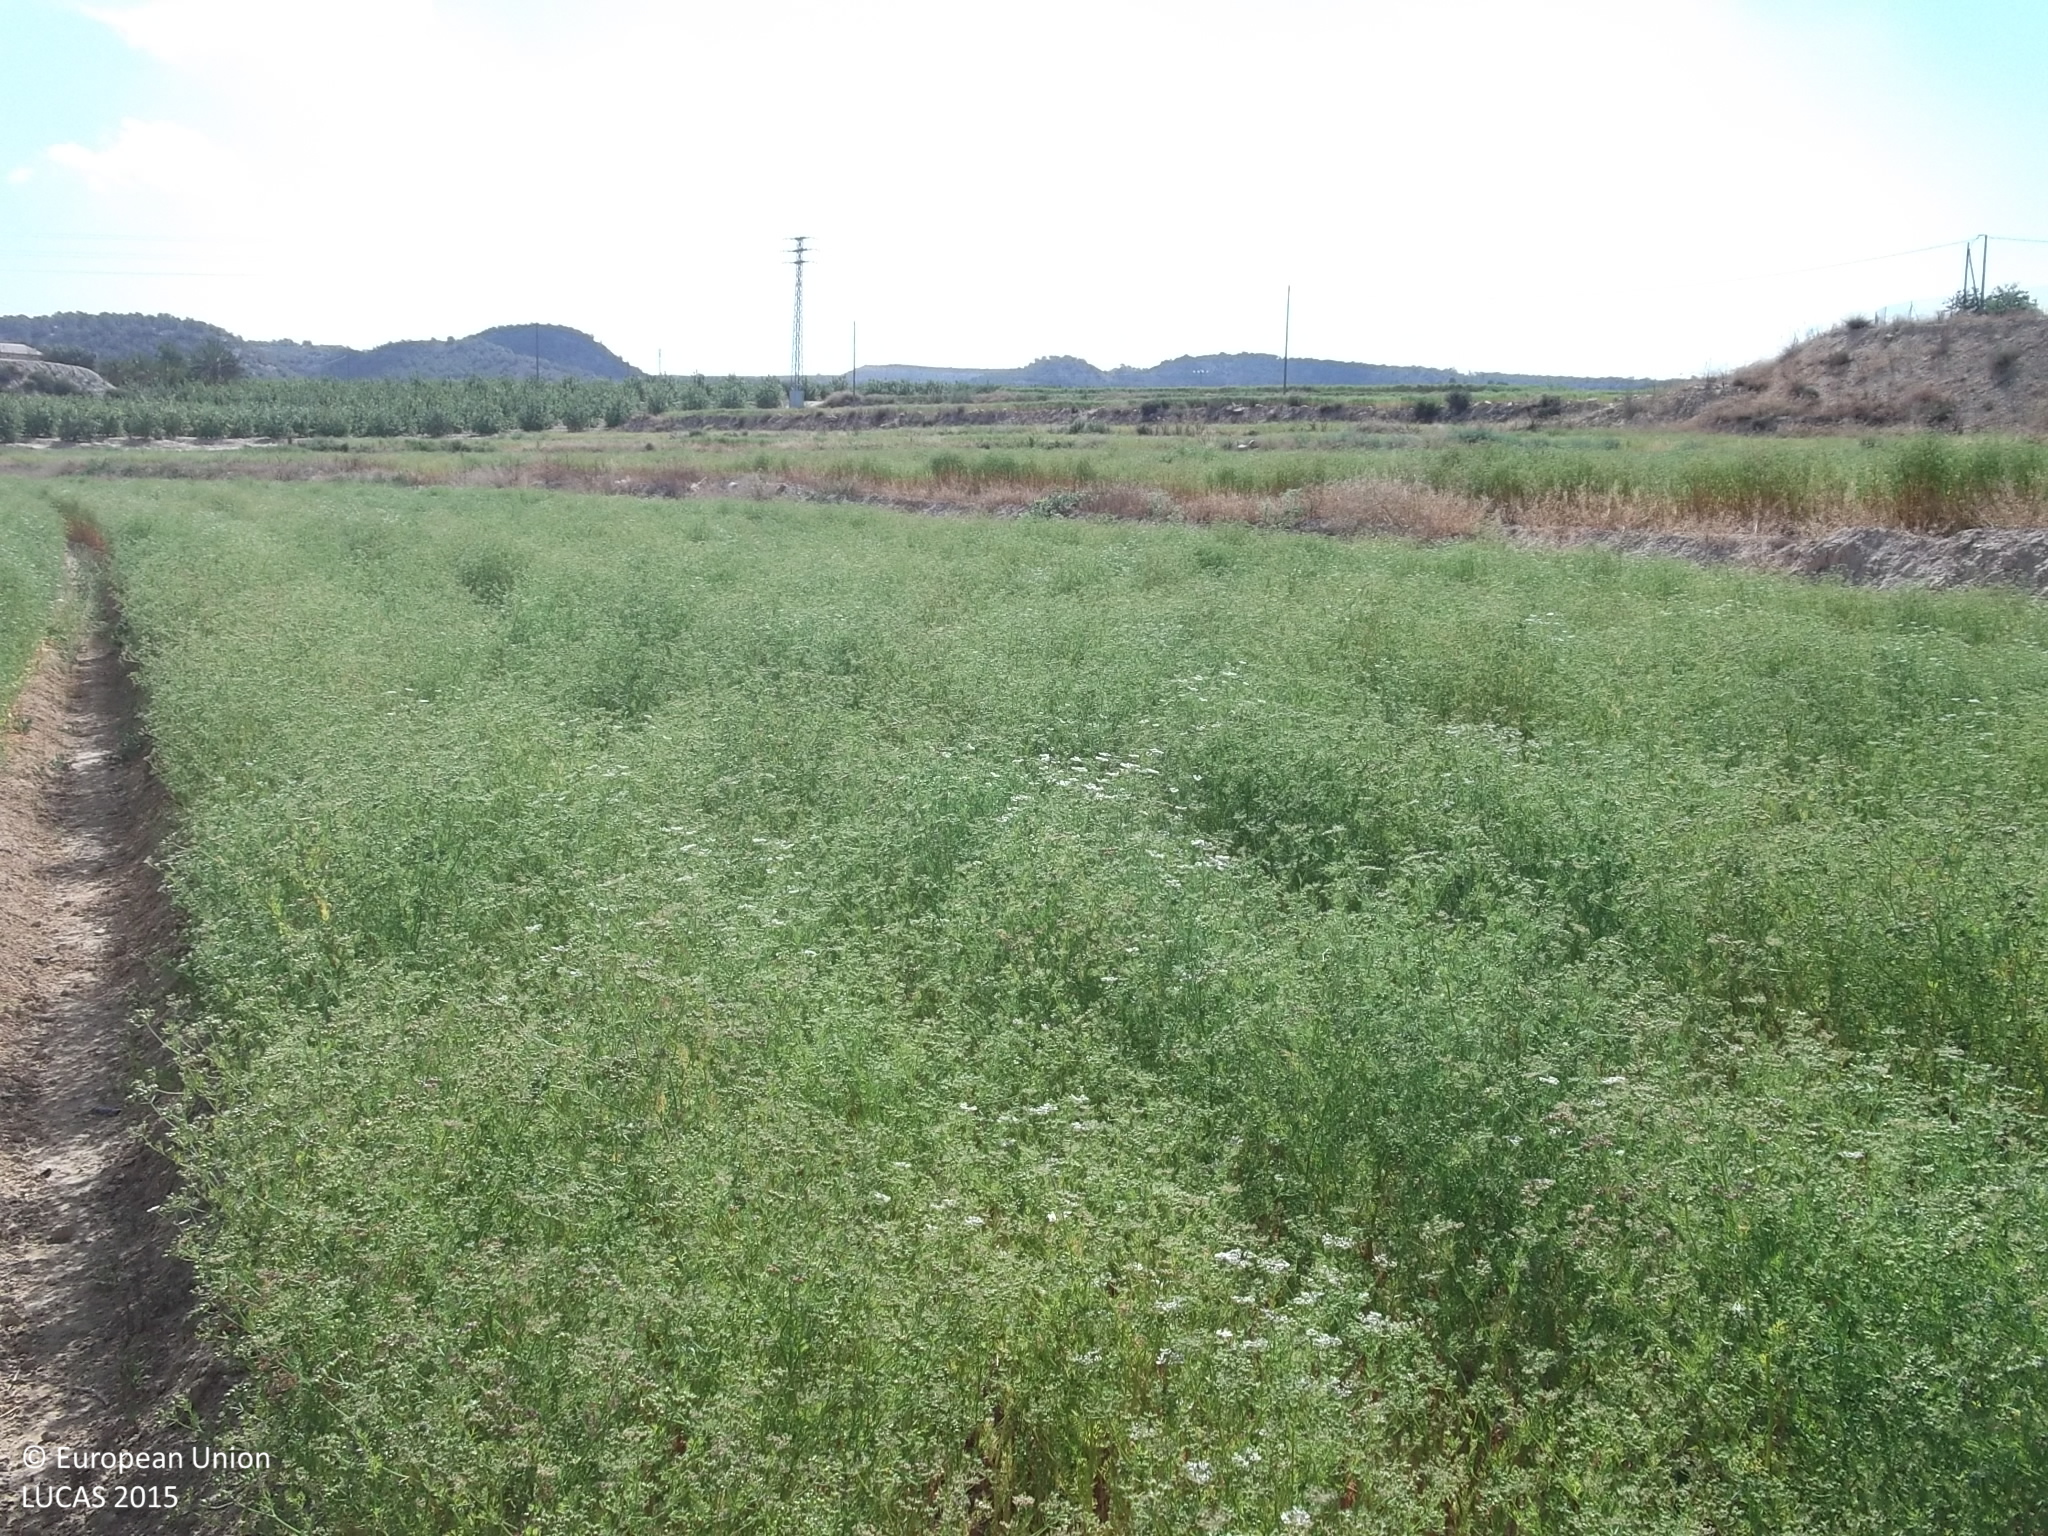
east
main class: Cropland
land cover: Other non-permanent industrial crops
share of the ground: > 75 %
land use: Agriculture (excluding fallow land and kitchen gardens)
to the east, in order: Other non-permanent industrial crops; Grass margins; Other non-permanent industrial crops; Tracks; Other non-permanent industrial crops; Grass margins; Other non-permanent industrial crops; Grass margins; Other non-permanent industrial crops; Grass margins; Other non-permanent industrial crops; Electric lines; Other non-permanent industrial crops; Grass margins; Other non-permanent industrial crops; Grass margins; Other non-permanent industrial crops; Electric lines; Other non-permanent industrial crops
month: May
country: ES
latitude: 38.0577
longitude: -0.8447
